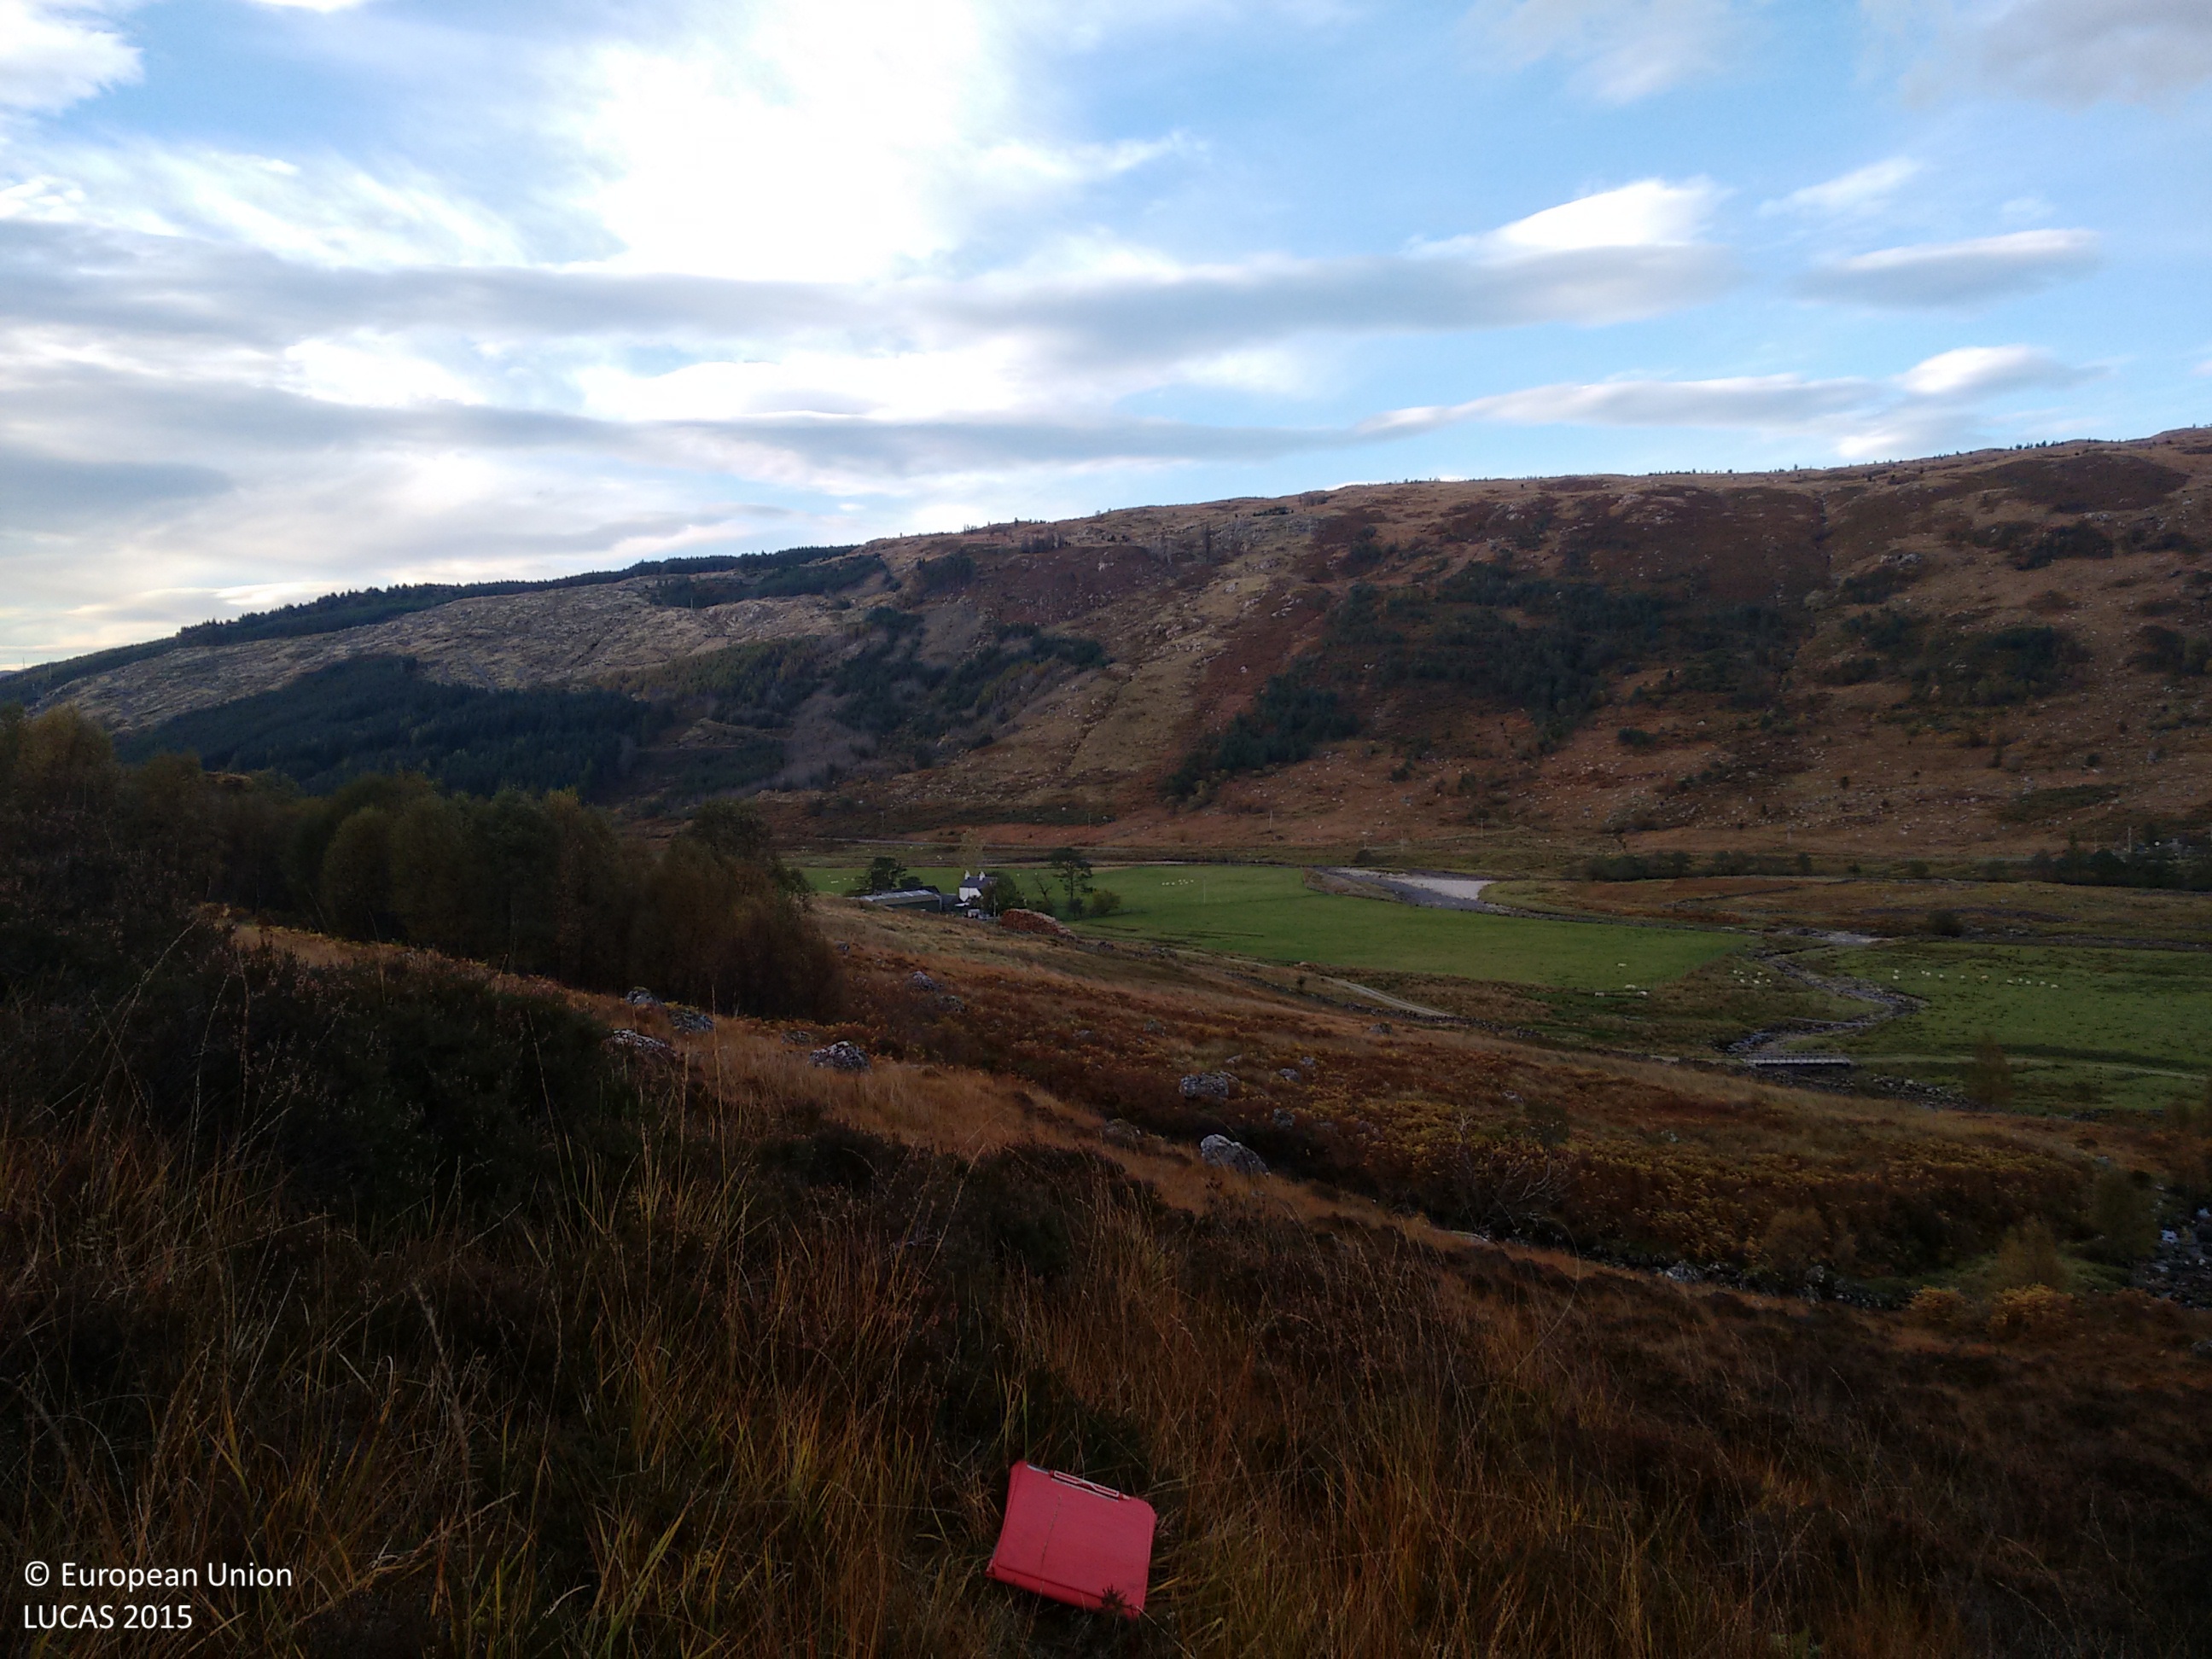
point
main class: Shrubland
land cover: Shrubland without tree cover
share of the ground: > 75 %
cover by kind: shrubs 60 %, herbaceous plants 30 %, lichens and mosses 5 %
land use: Agriculture (excluding fallow land and kitchen gardens)
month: October
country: GB
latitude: 56.6857
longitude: -5.5144
